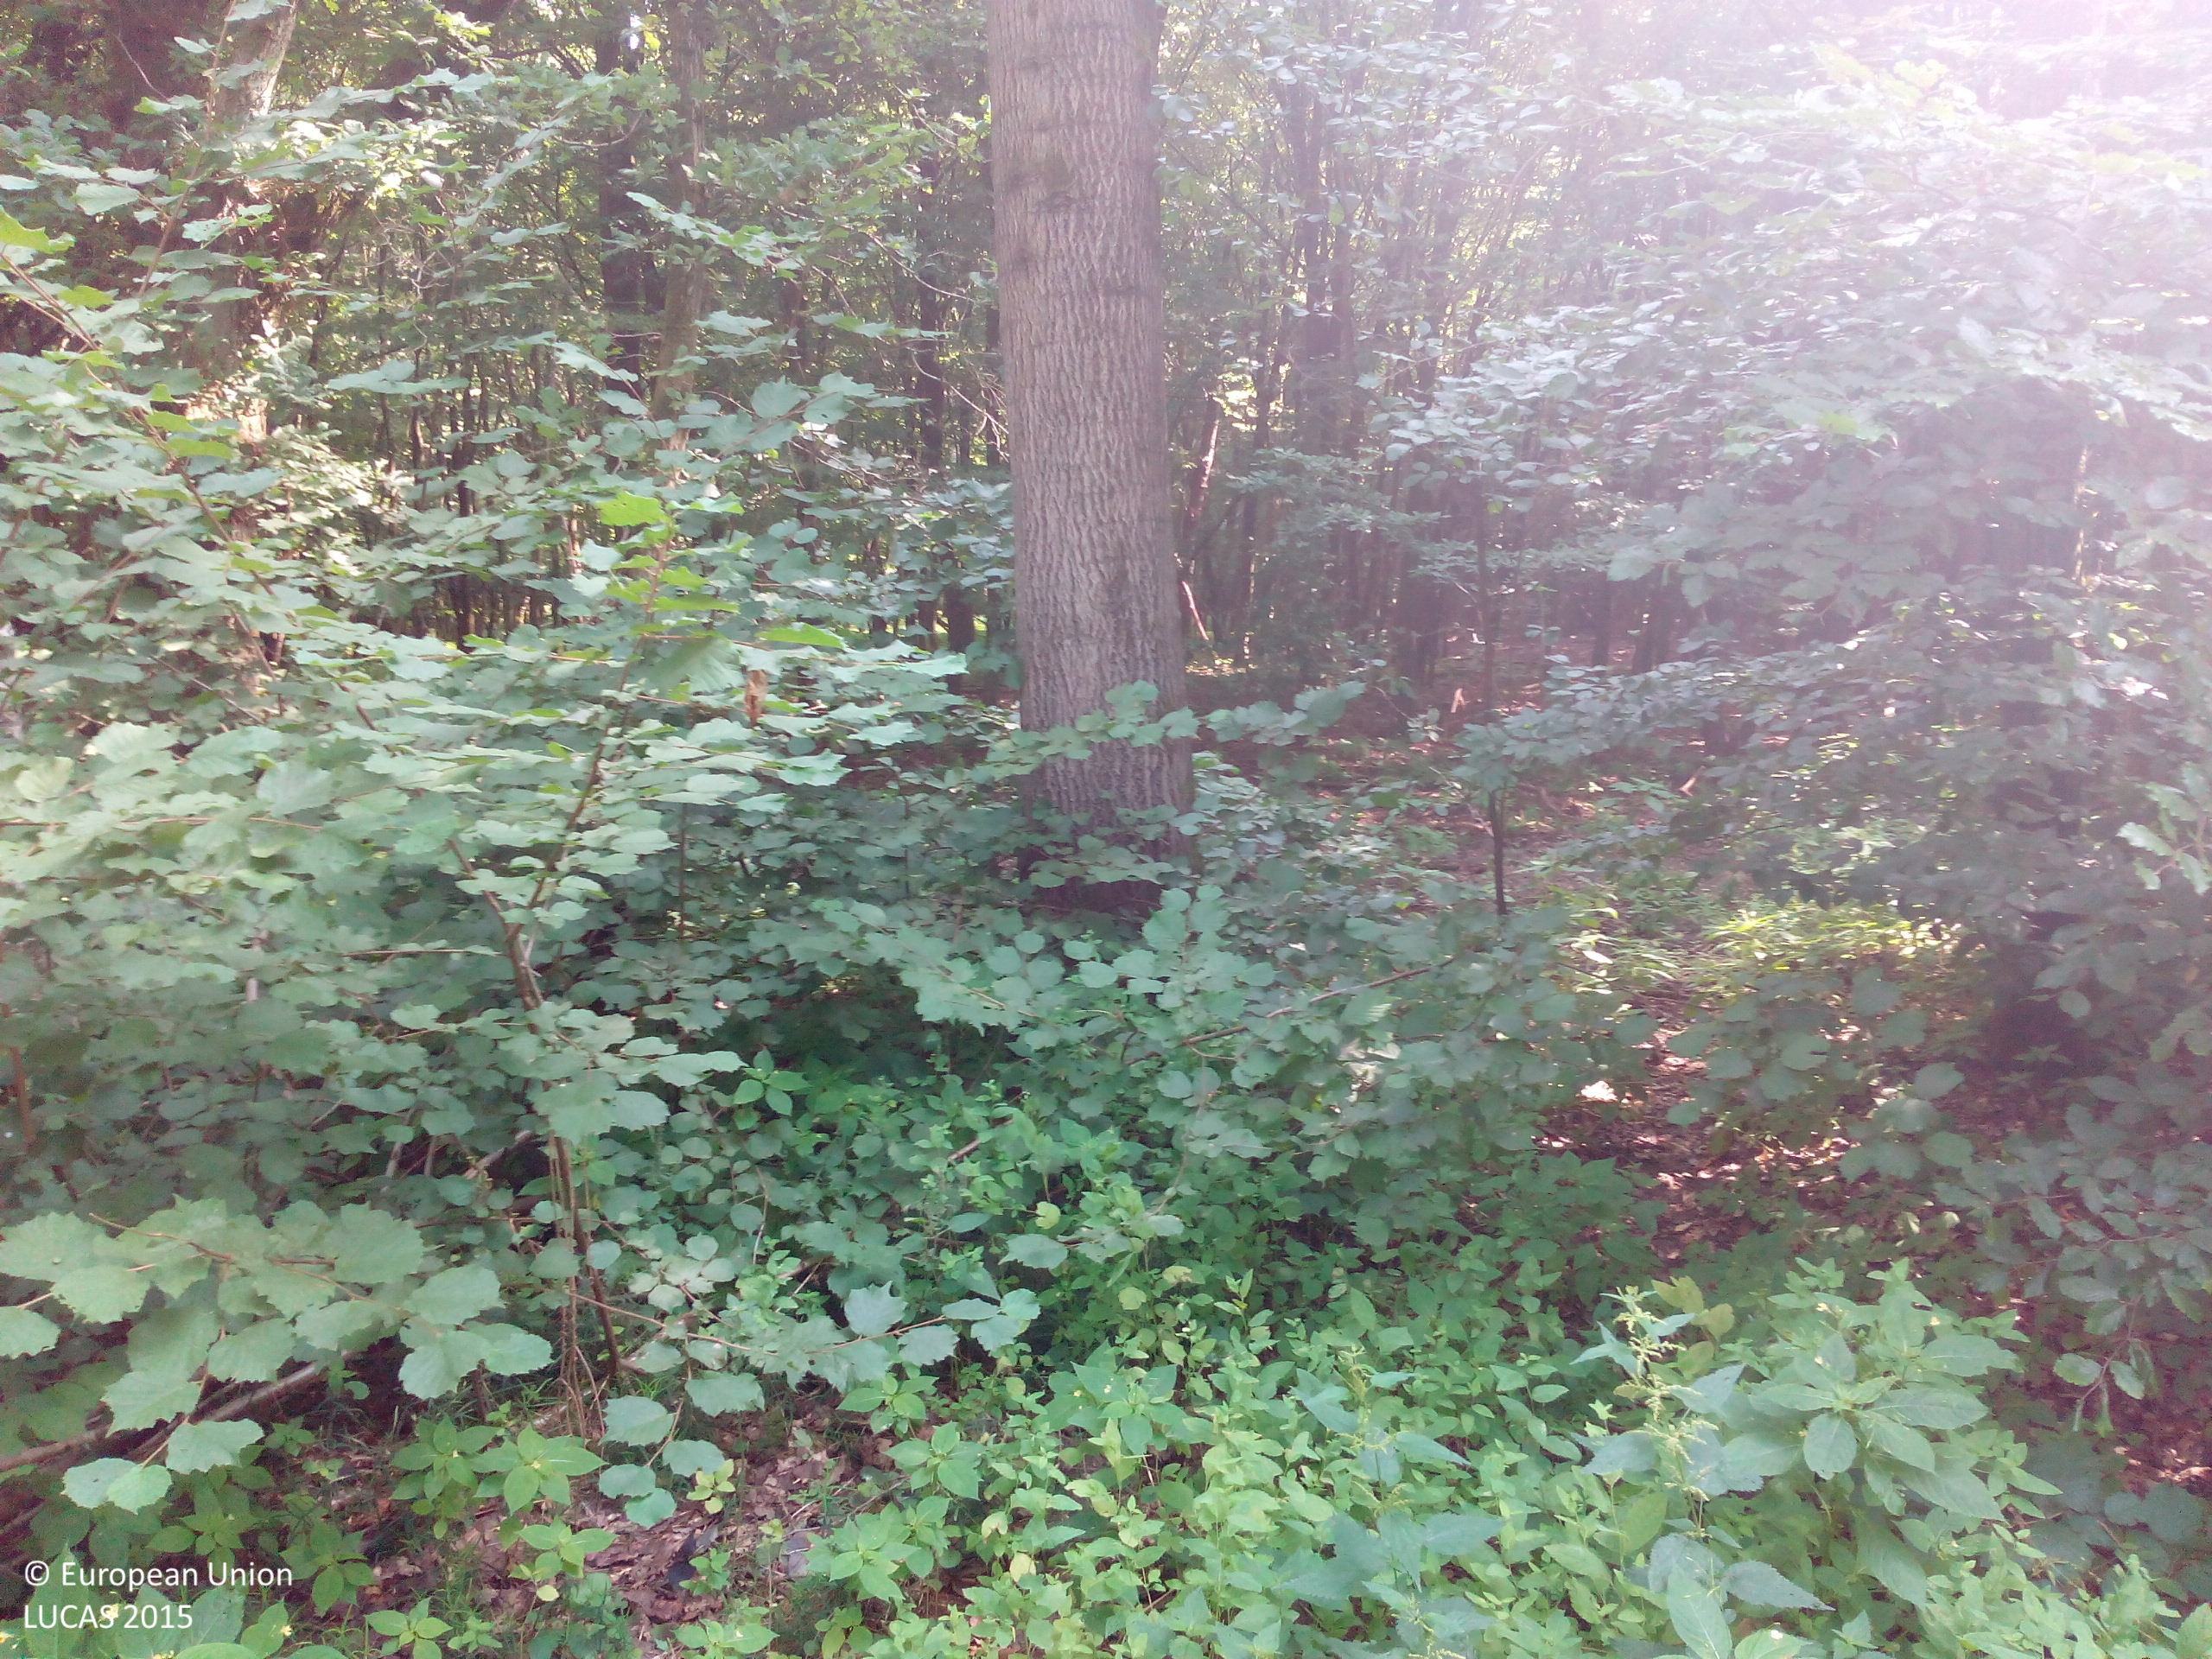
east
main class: Woodland
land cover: Broadleaved woodland
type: beech forest
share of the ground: > 75 %
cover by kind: broadleaved forest trees 100 %
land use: Forestry
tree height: > 5 m
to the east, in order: Broadleaved woodland; Grassland without tree/shrub cover
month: August
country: DE
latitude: 53.0061
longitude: 10.3128
